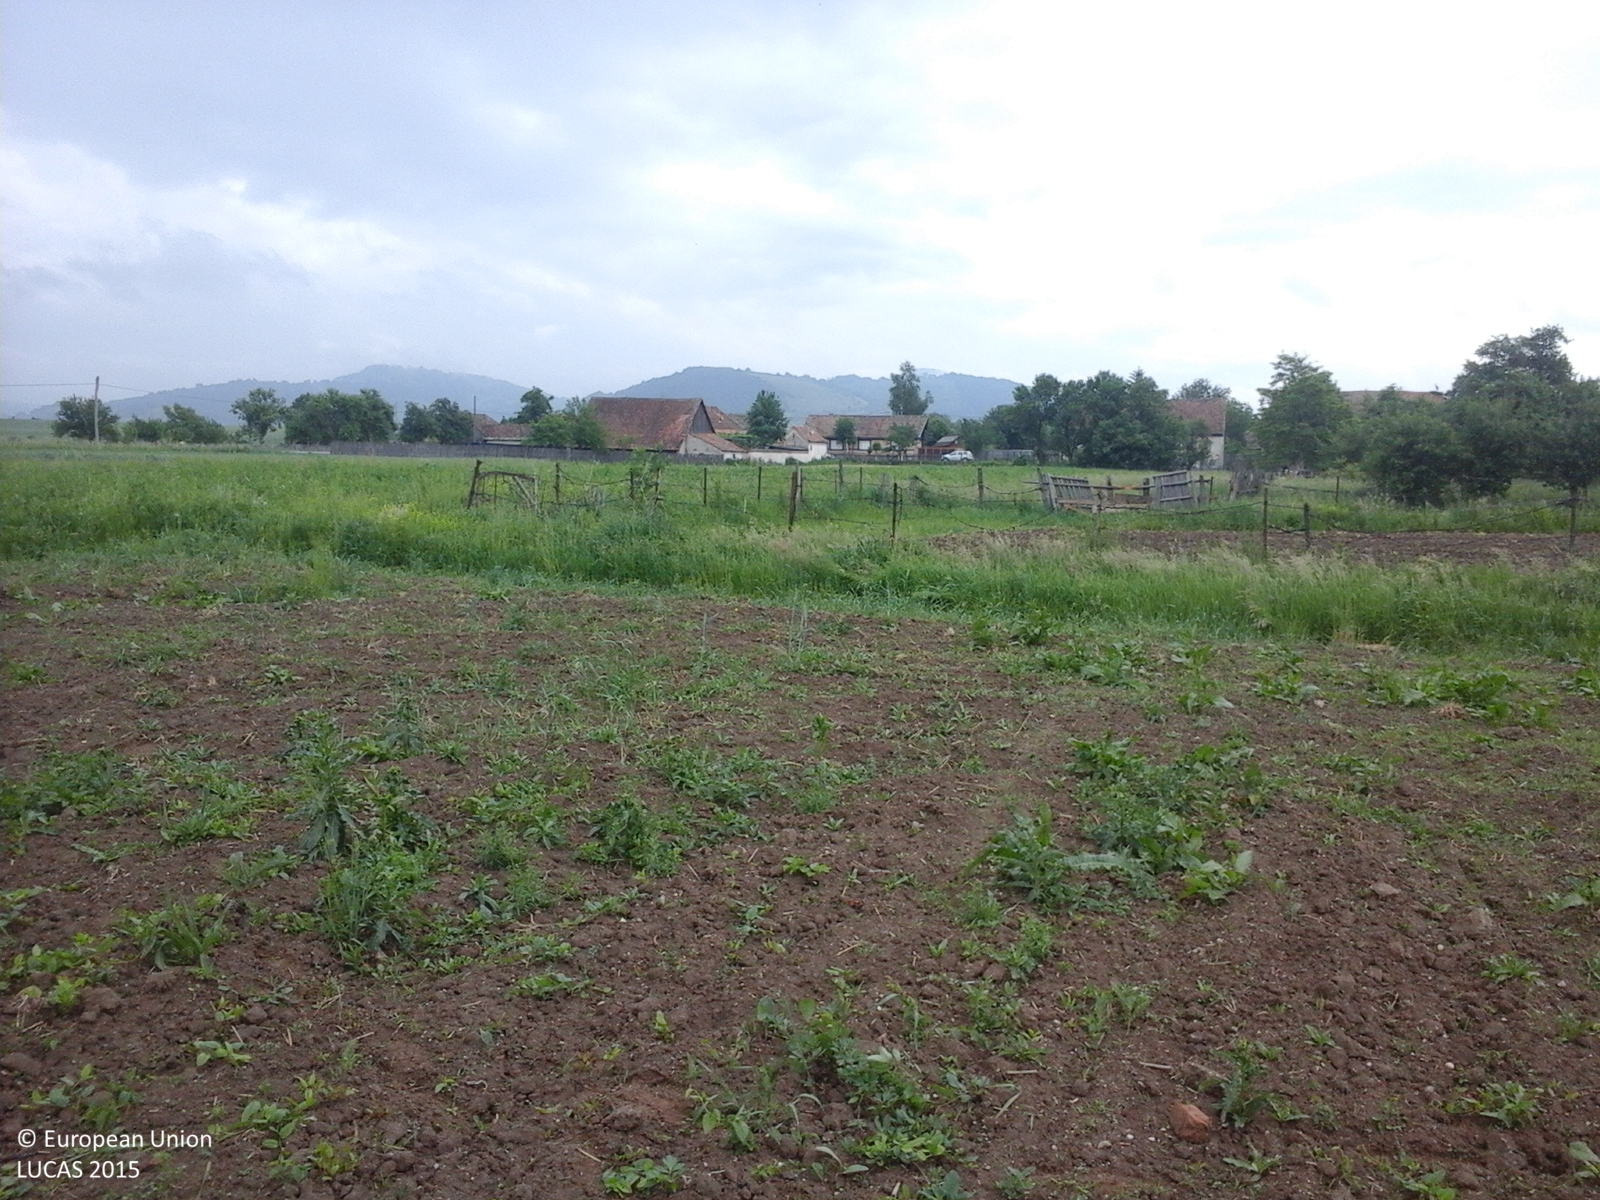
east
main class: Cropland
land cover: Lucerne
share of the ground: 10 - 25 %
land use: Agriculture (excluding fallow land and kitchen gardens)
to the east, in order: Lucerne; Other leguminous and mixtures for fodder; Grass margins; Other leguminous and mixtures for fodder; Common wheat; Lucerne; Grass margins; Fences; Grassland without tree/shrub cover; Potatoes; Fences; Electric lines; Grass margins; Paved roads, cycling and walking lanes; Grass margins; Fences; Grassland without tree/shrub cover; Artificial constructions in urban areas; Grass margins; Tracks; Maize
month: May
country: RO
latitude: 45.8782
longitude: 25.2106
